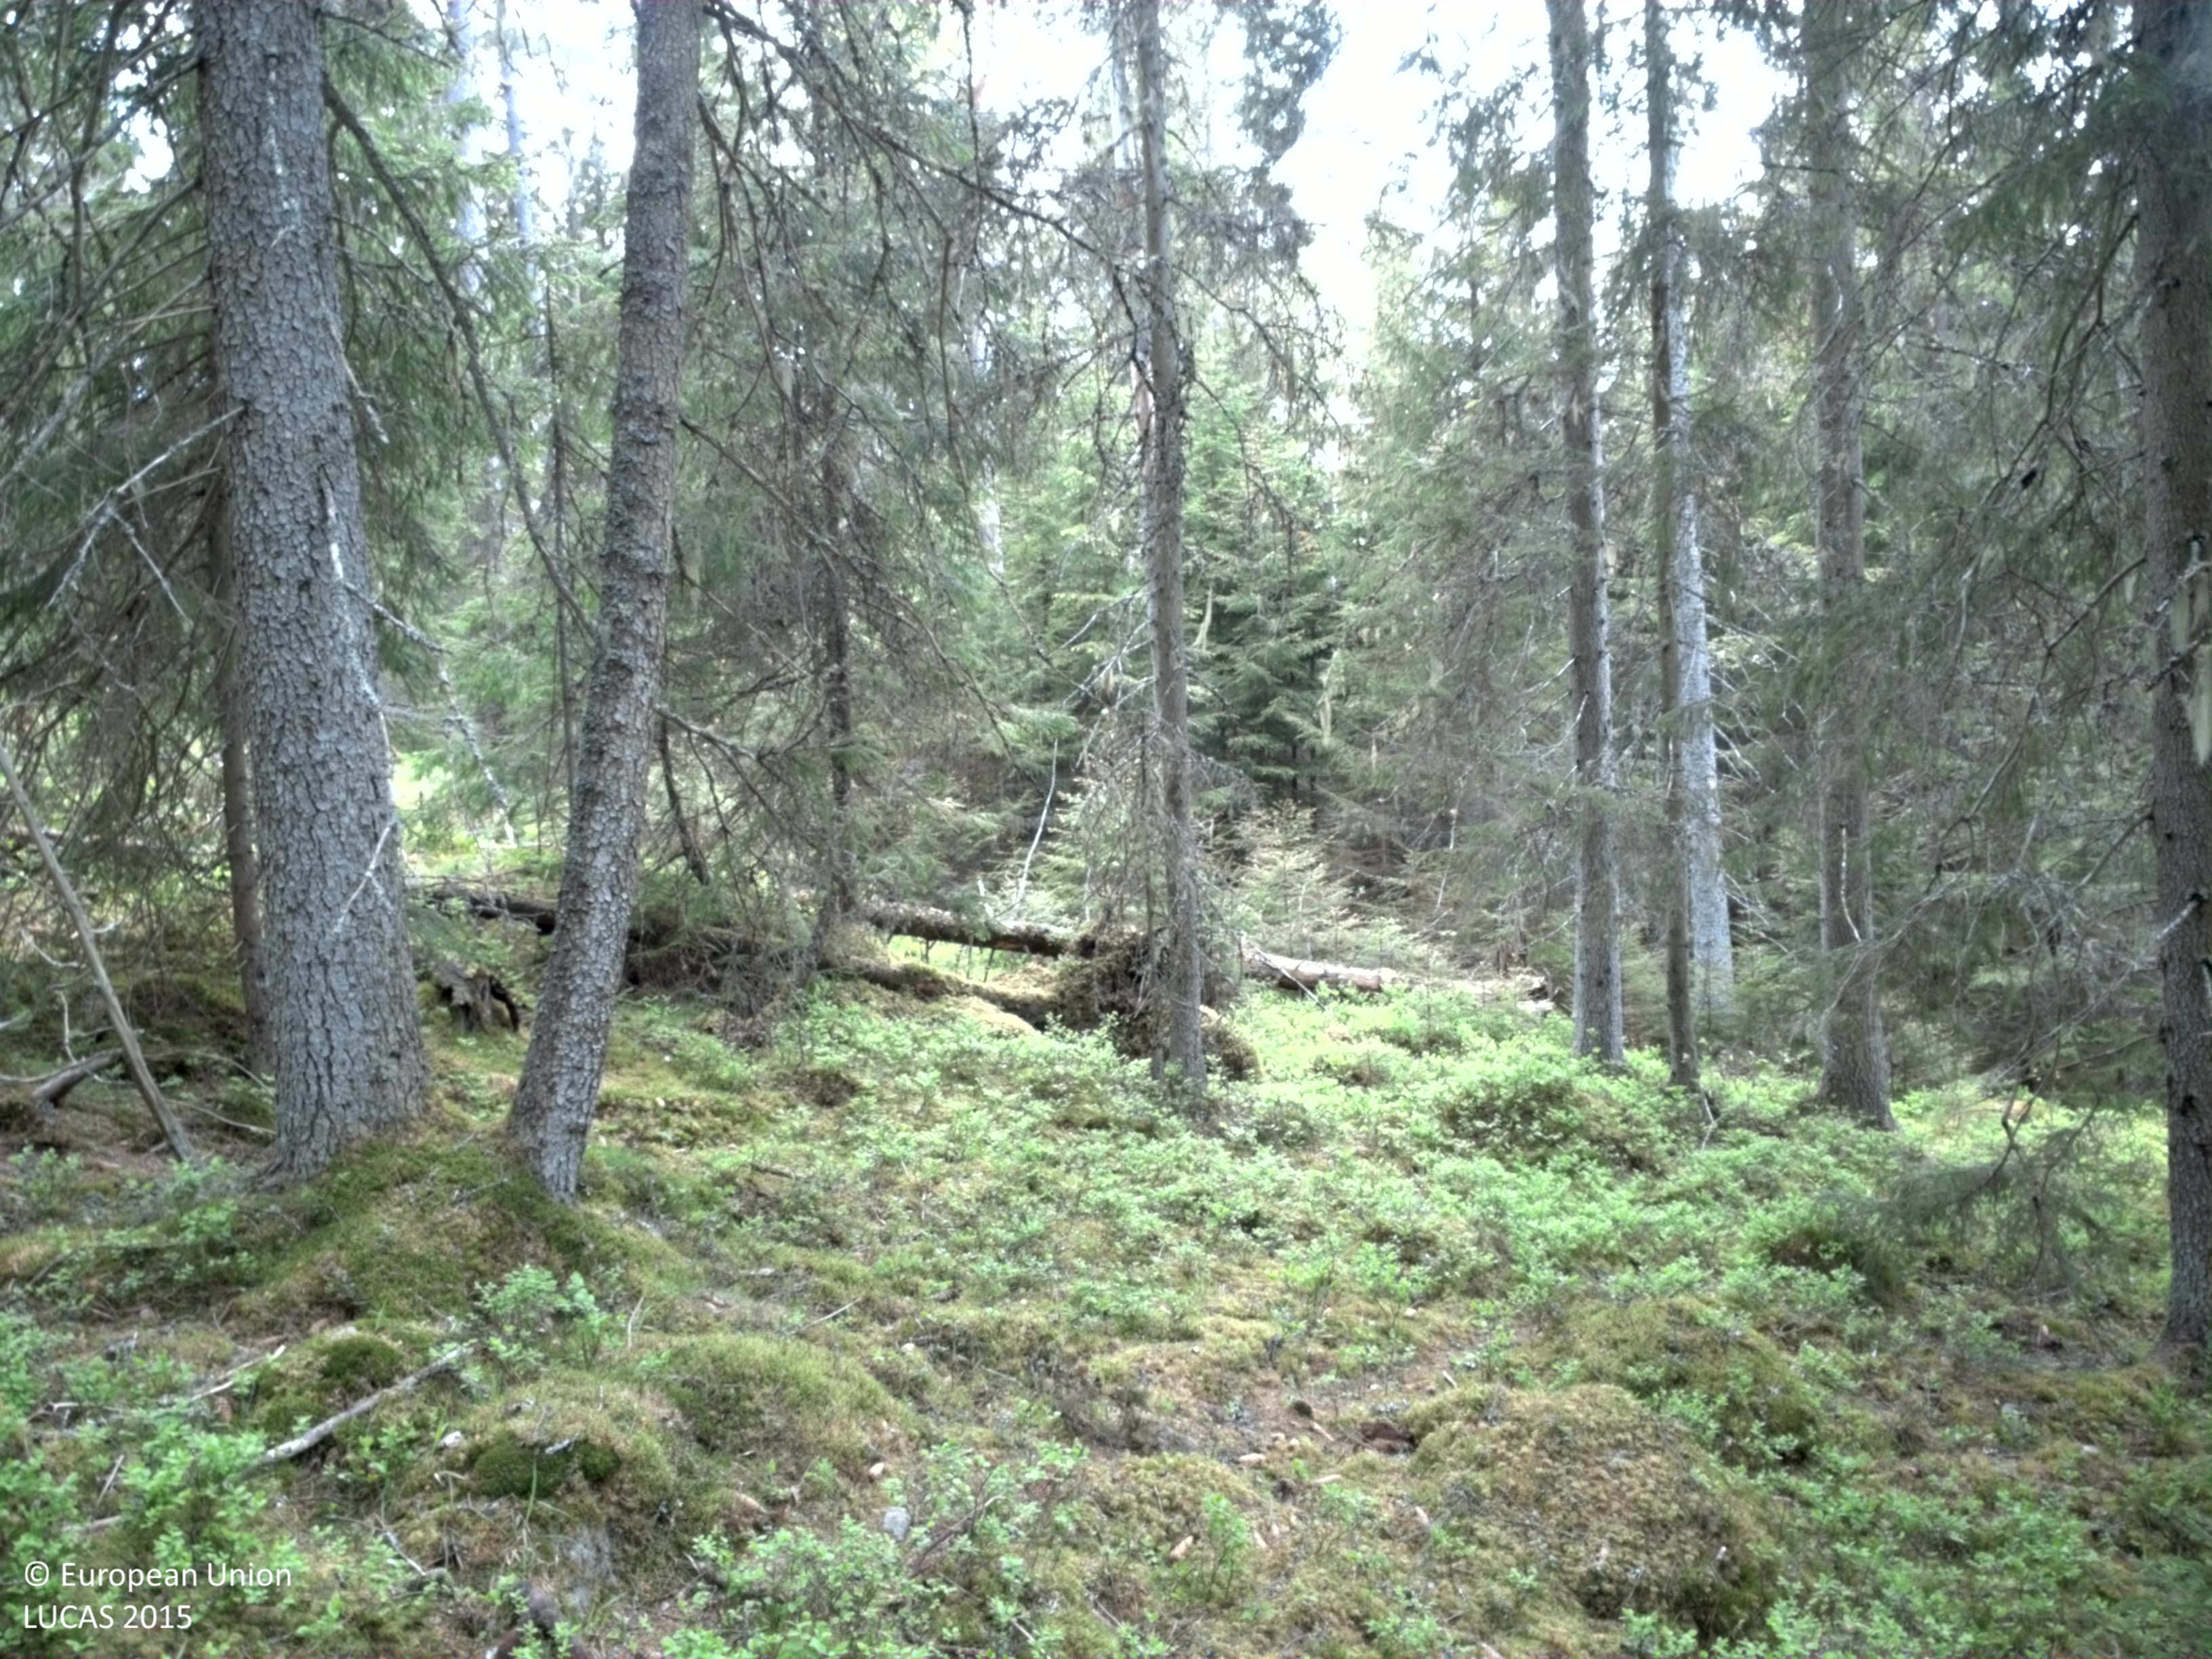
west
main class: Woodland
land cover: Spruce dominated coniferous woodland
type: boreal forest
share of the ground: 50 - 75 %
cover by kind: coniferous forest trees 50 %, shrubs 25 %, lichens and mosses 25 %
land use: Forestry
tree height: > 5 m
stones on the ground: 10 - 25 %
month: May
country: SE
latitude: 57.4435
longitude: 15.4117
